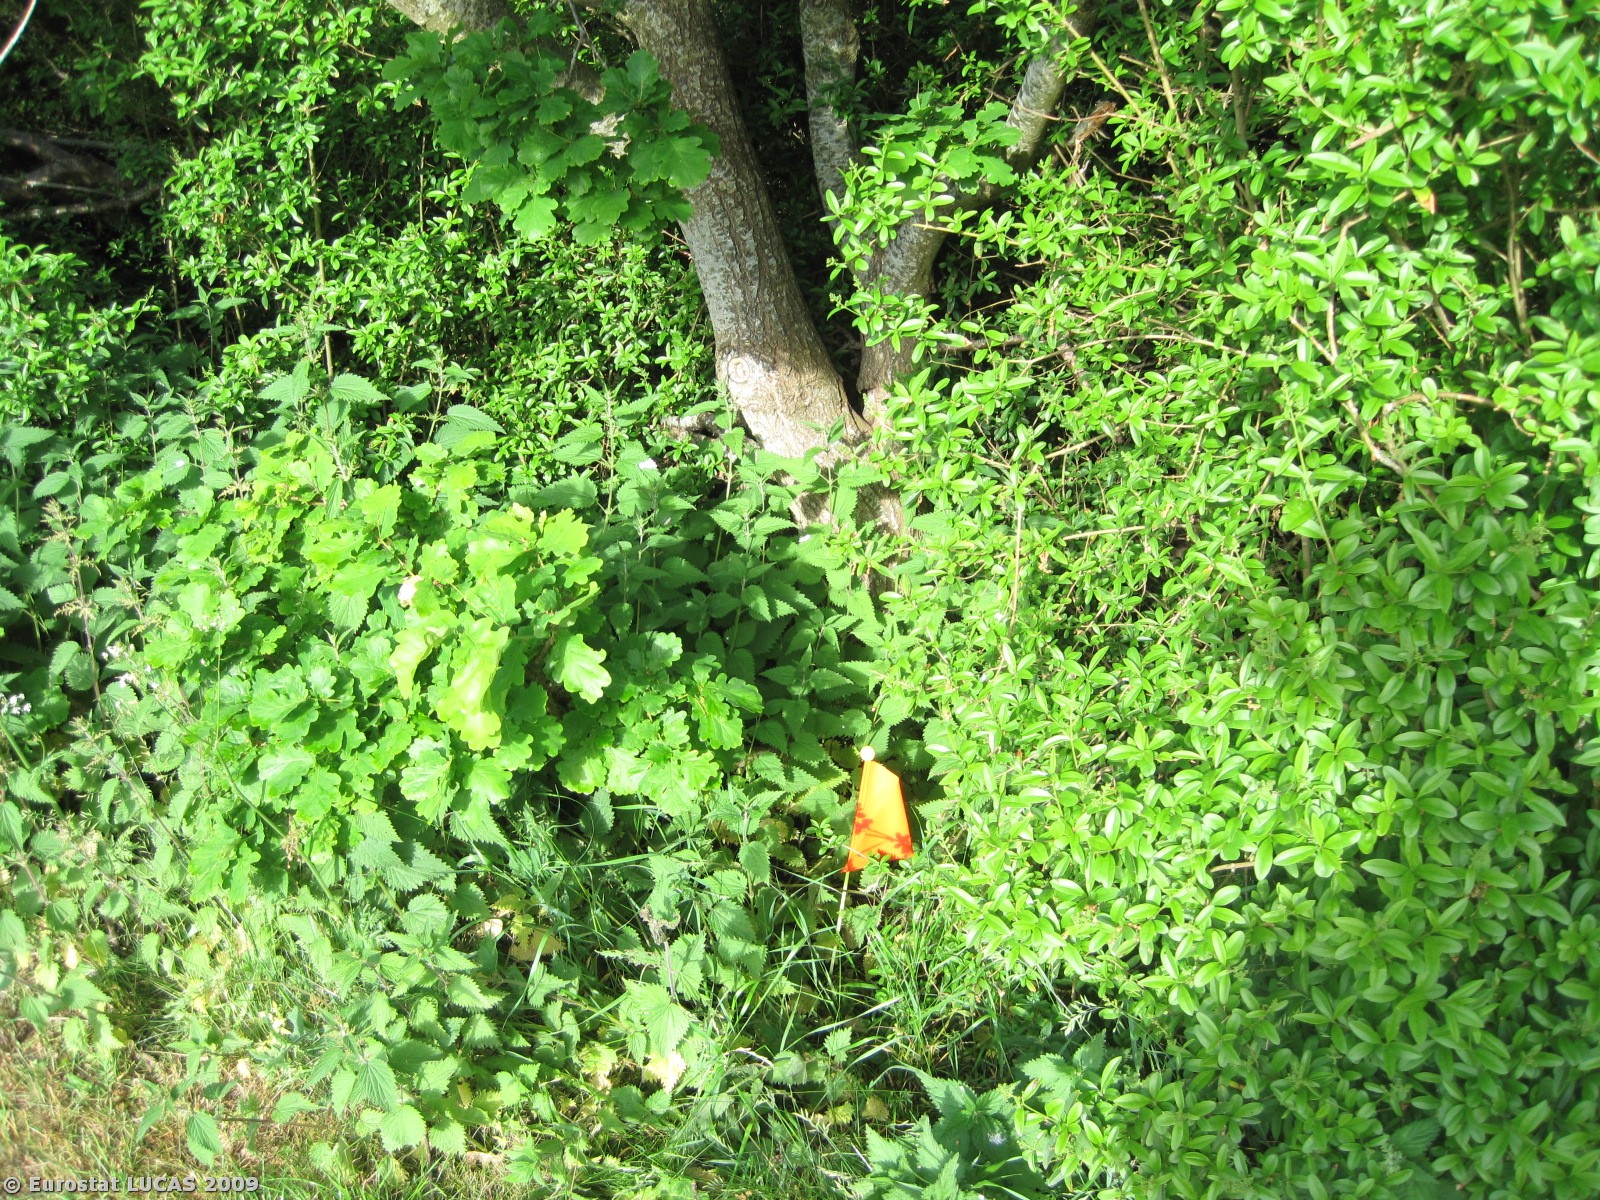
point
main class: Woodland
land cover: Broadleaved woodland
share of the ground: 50 - 75 %
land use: Amenities, museums, leisure
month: June
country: DK
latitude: 57.1046
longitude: 10.0824
